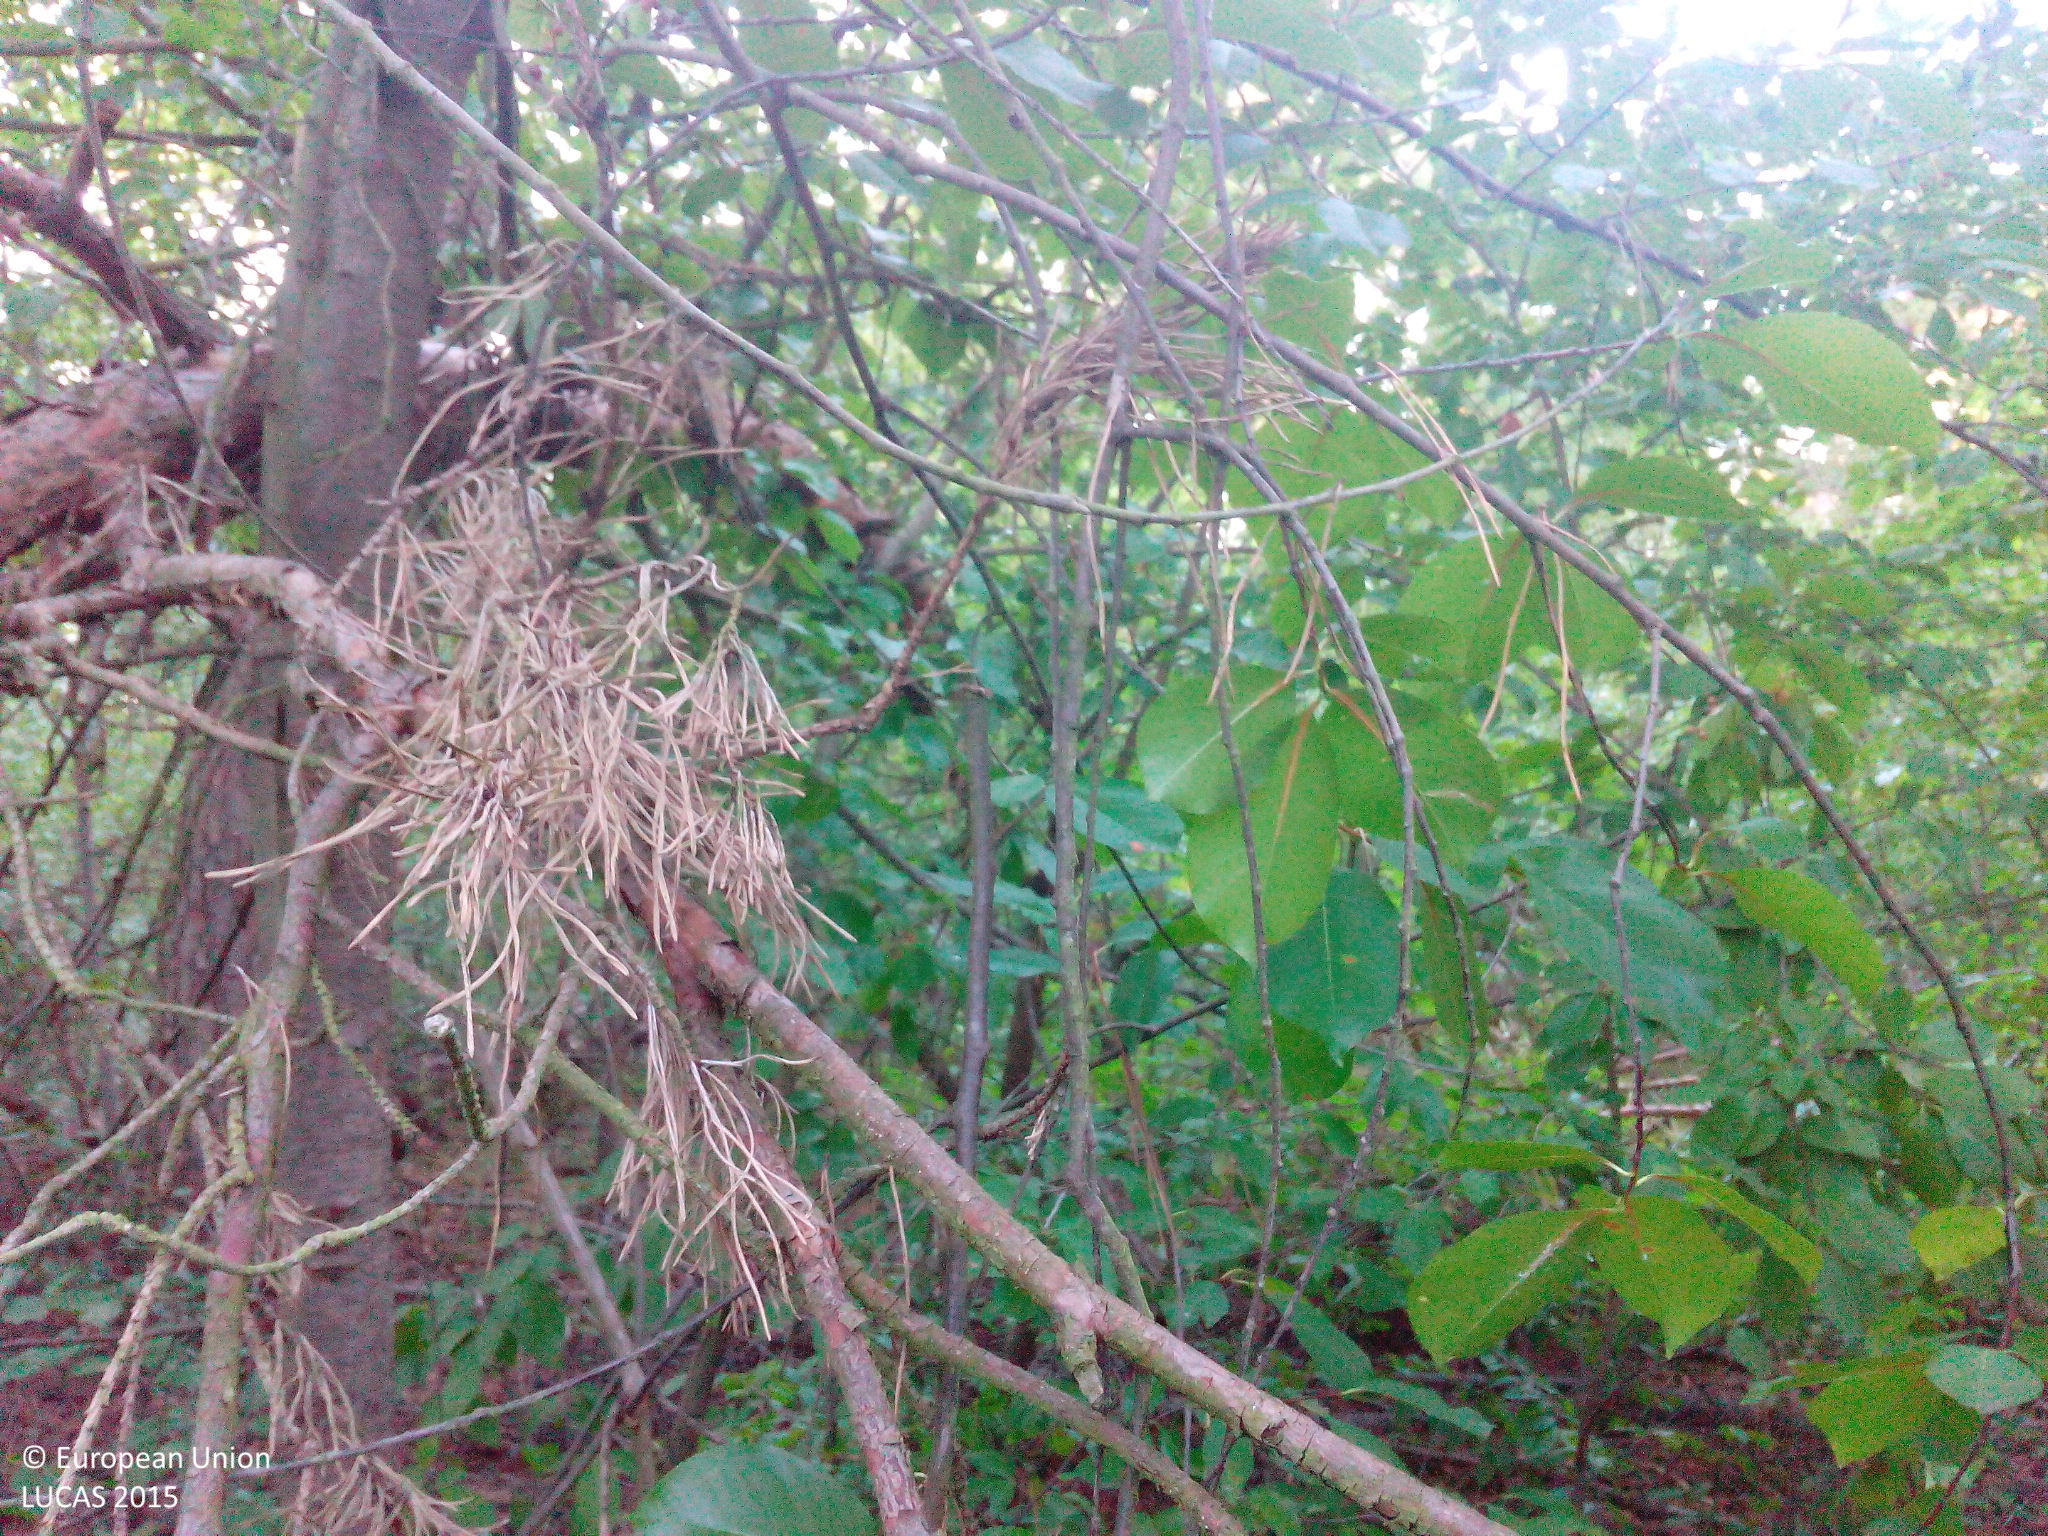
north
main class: Woodland
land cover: Pine dominated mixed woodland
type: hemiboreal forest and nemoral coniferous forest and mixed broadleaved-coniferous forest
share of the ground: 50 - 75 %
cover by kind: shrubs 40 %, broadleaved forest trees 30 %, coniferous forest trees 20 %, unconsolidated bare surface 10 %
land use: Forestry
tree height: > 5 m
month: August
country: DE
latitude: 49.4376
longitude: 8.5525
